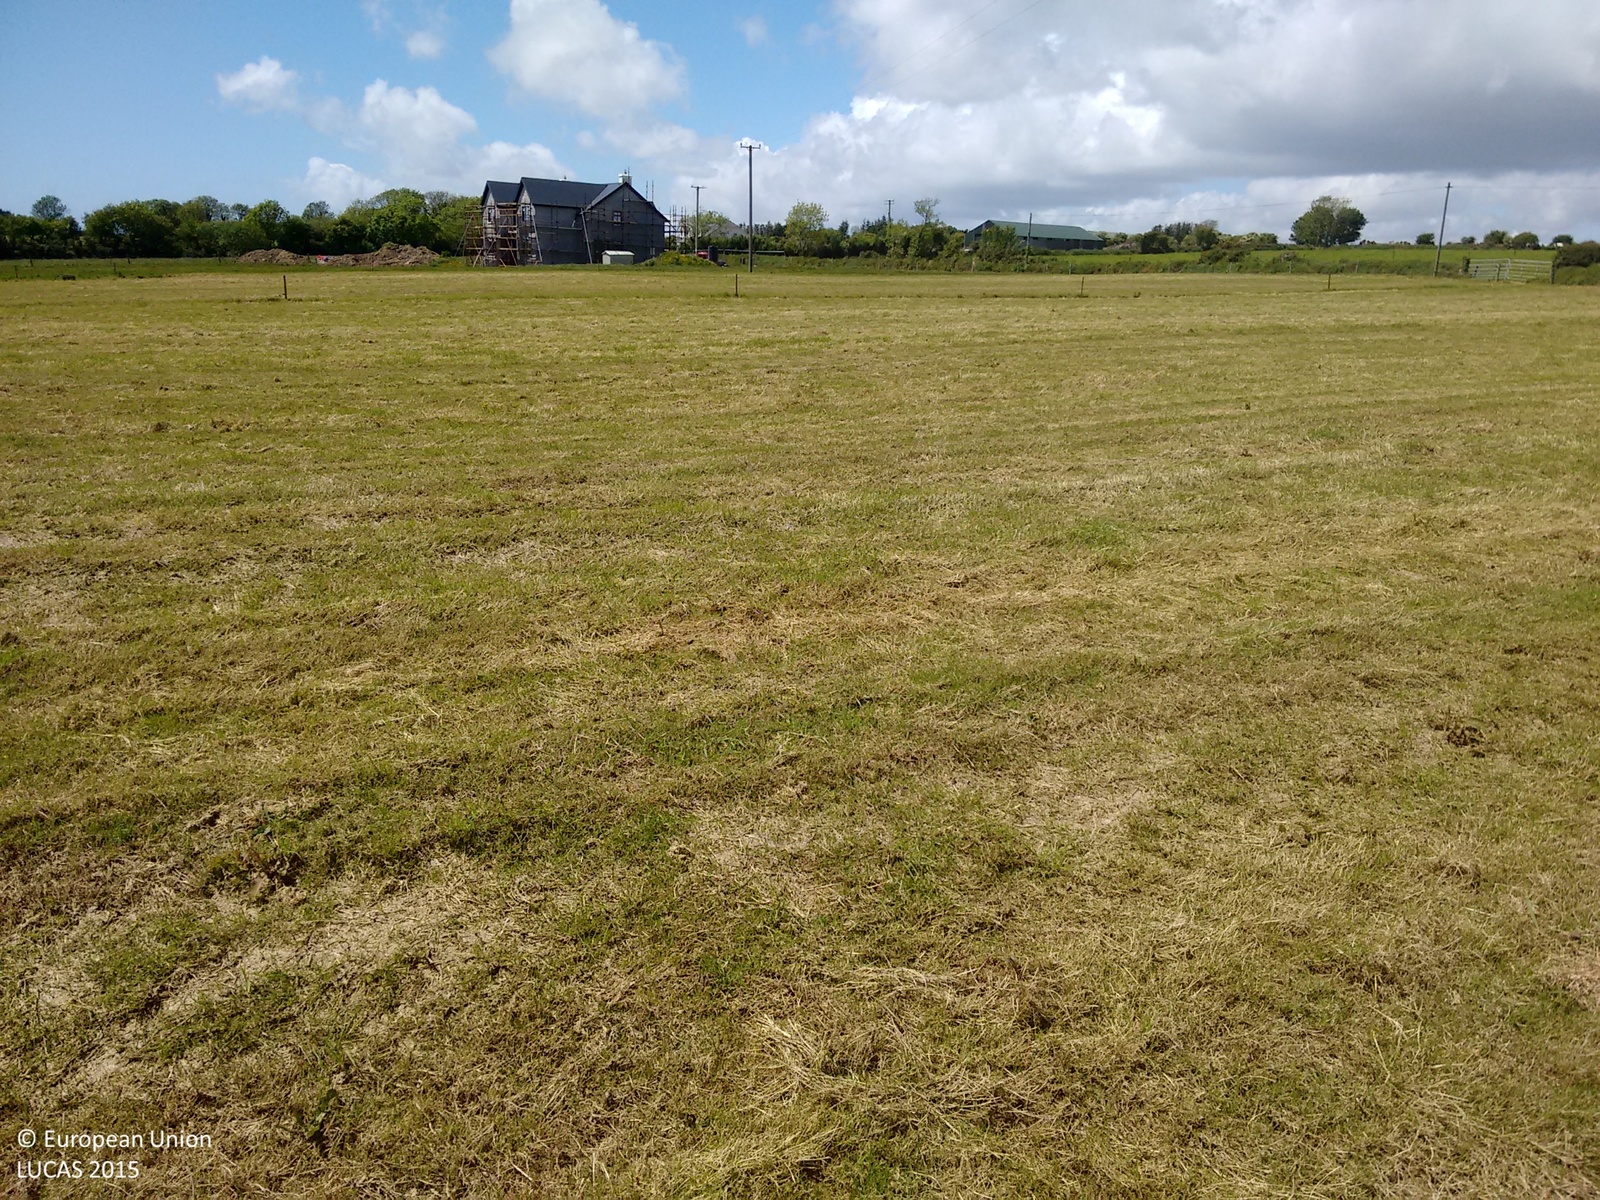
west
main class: Grassland
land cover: Grassland without tree/shrub cover
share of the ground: > 75 %
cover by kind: herbaceous plants 80 %, unconsolidated bare surface 20 %
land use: Agriculture (excluding fallow land and kitchen gardens)
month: June
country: IE
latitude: 51.6673
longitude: -8.6937
